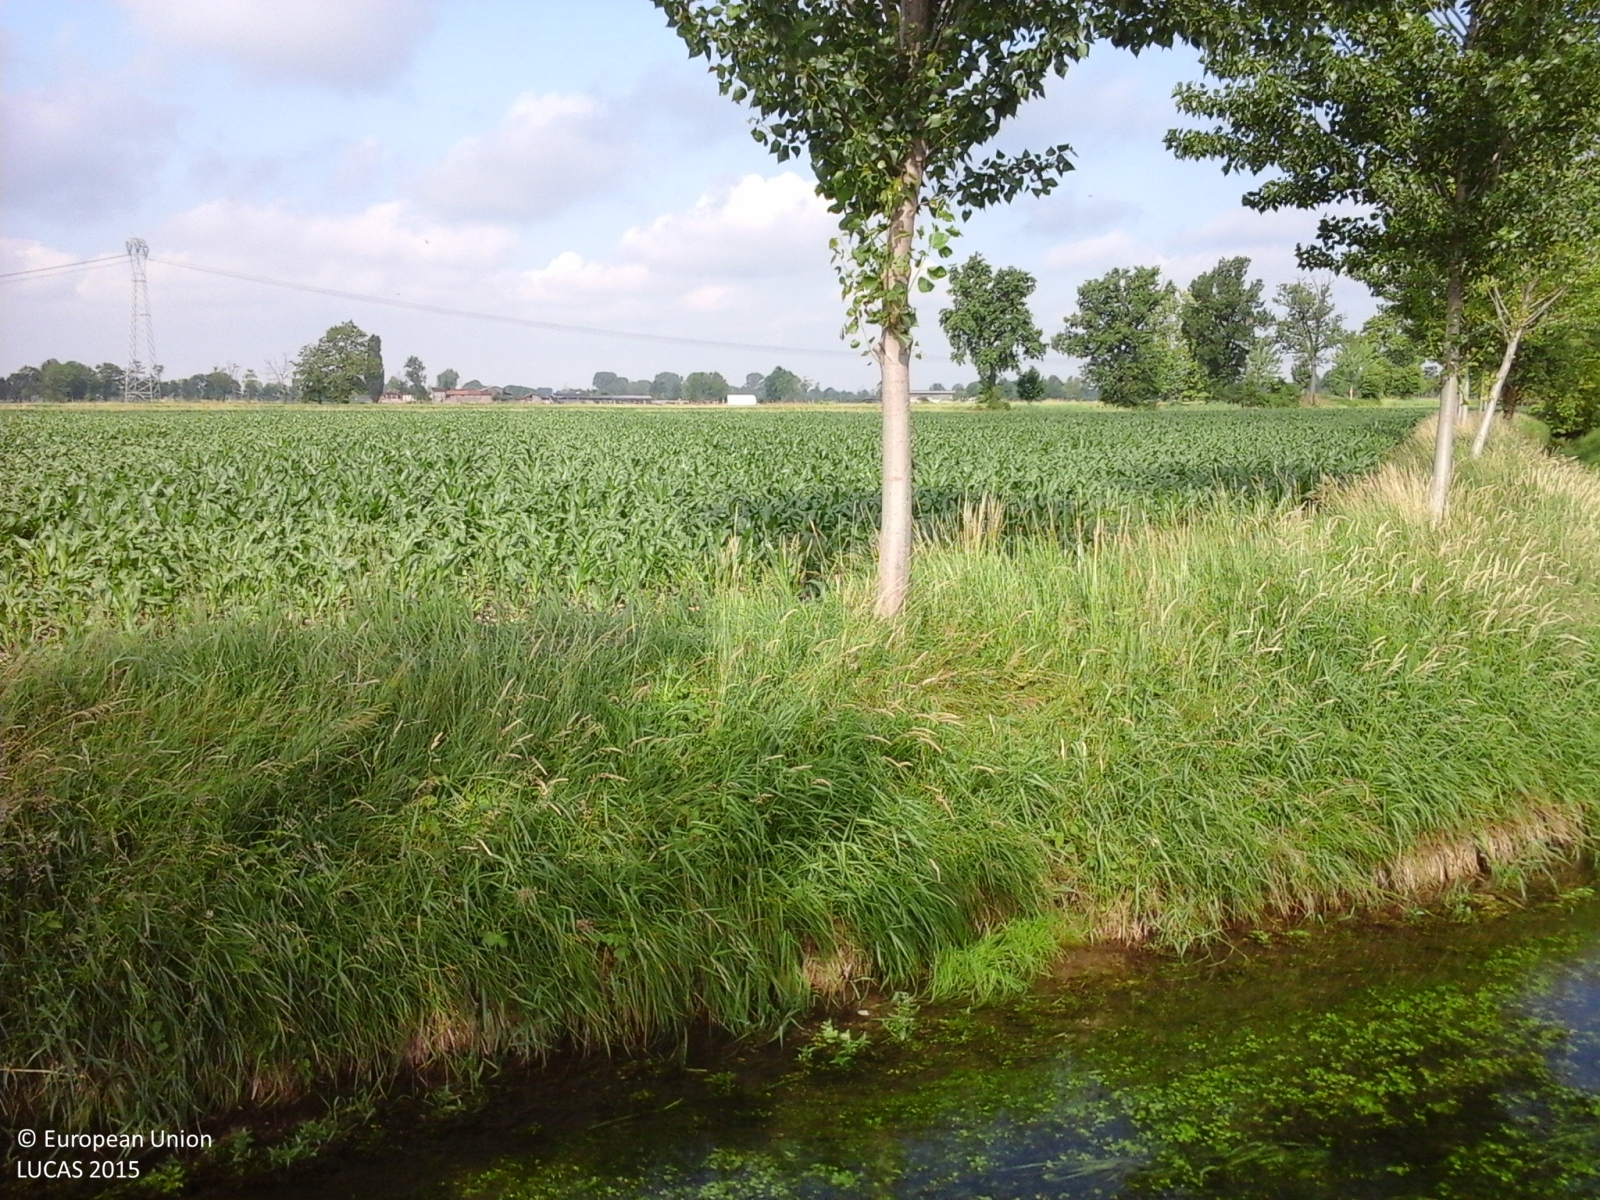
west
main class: Grassland
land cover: Grassland with sparse tree/shrub cover
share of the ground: > 75 %
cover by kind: herbaceous plants 85 %, shrubs 10 %, broadleaved forest trees 5 %
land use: Agriculture (excluding fallow land and kitchen gardens)
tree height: > 5 m
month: May
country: IT
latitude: 45.4312
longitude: 9.5279
